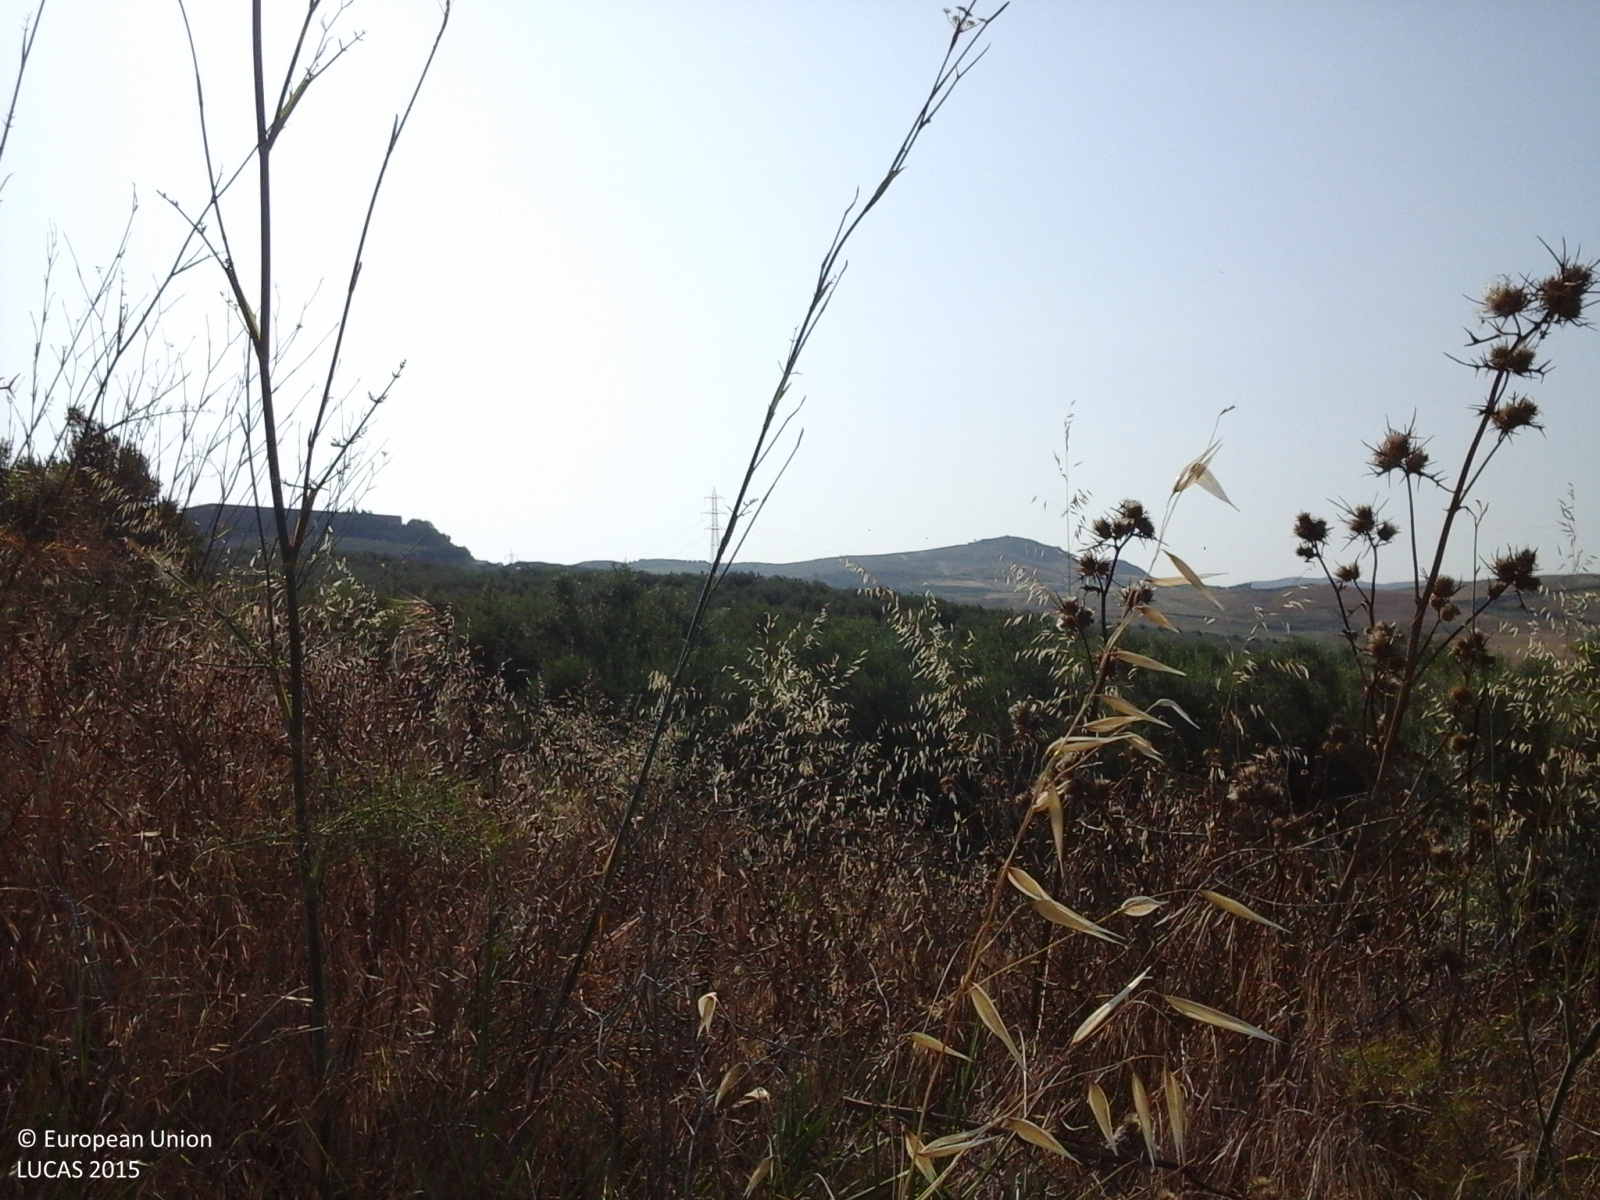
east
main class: Cropland
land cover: Olive groves
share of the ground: 25 - 50 %
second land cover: Other bare soil
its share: > 75 %
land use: Agriculture (excluding fallow land and kitchen gardens)
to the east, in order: Olive groves; Other bare soil; Grassland without tree/shrub cover; Ditches and canals; Grassland without tree/shrub cover; Olive groves
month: July
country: IT
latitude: 37.1721
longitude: 14.0117
